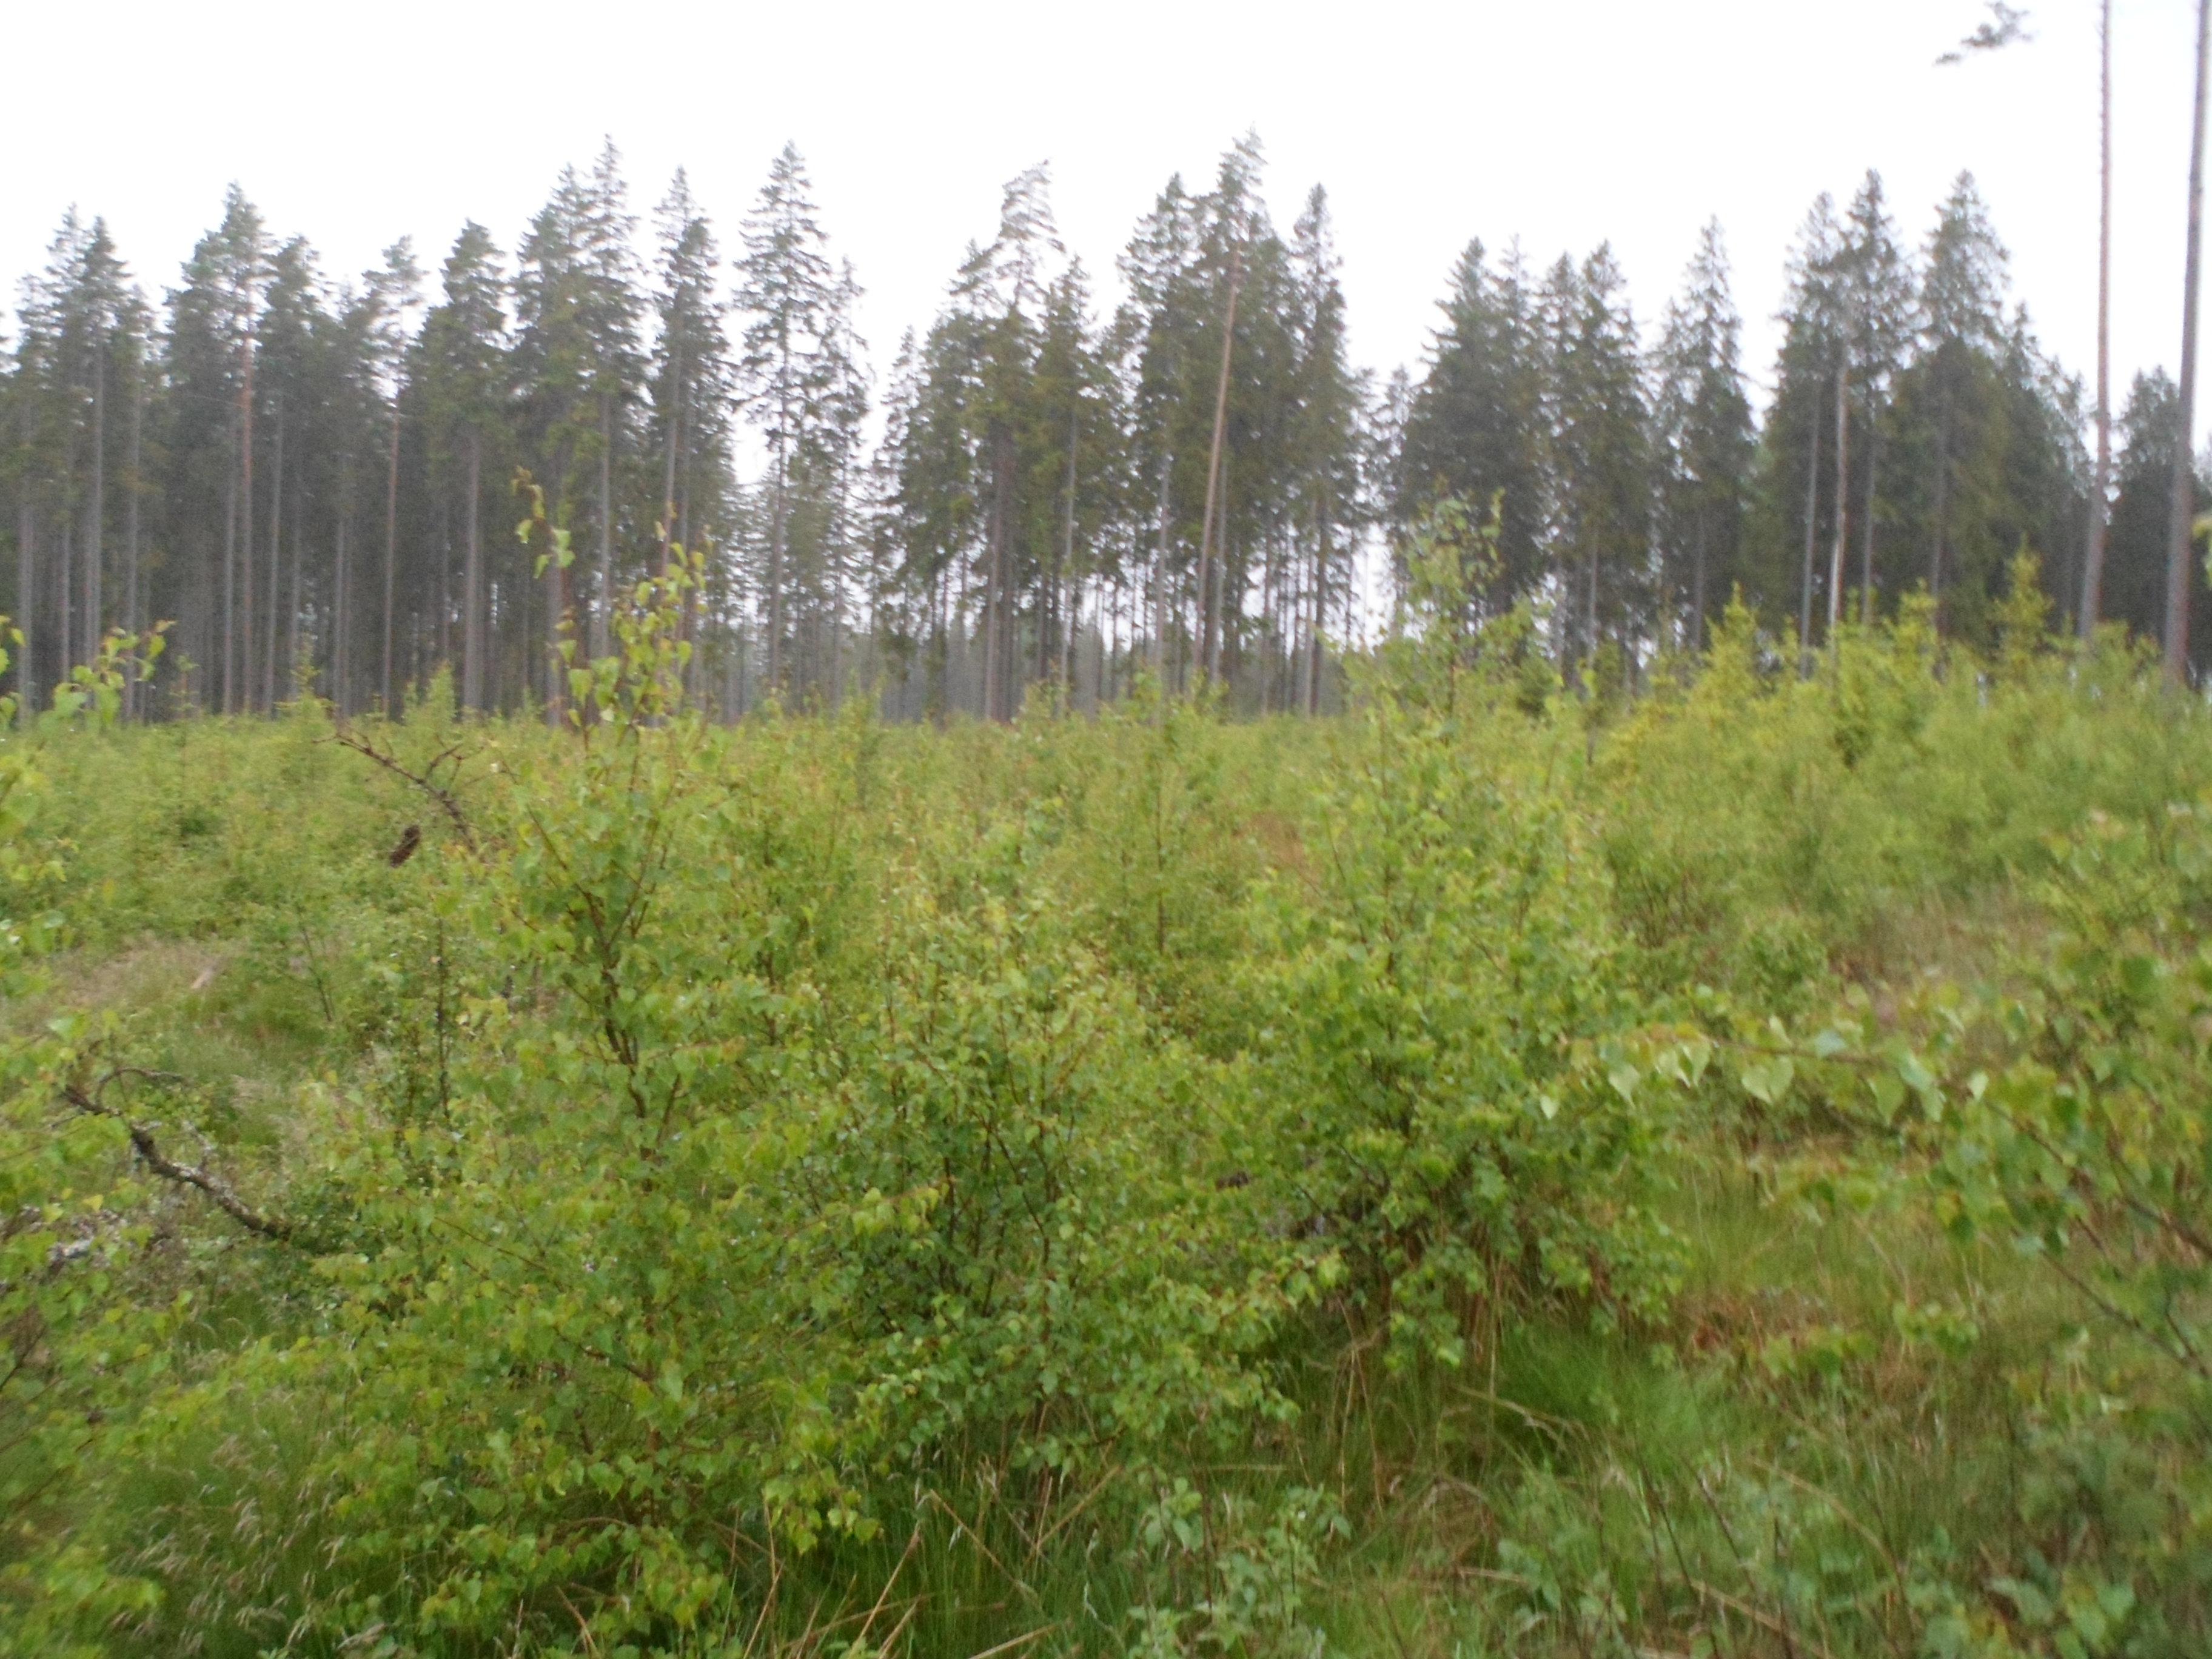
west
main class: Woodland
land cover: Broadleaved woodland
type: boreal forest
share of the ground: 50 - 75 %
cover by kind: broadleaved forest trees 65 %, herbaceous plants 20 %, shrubs 10 %, coniferous forest trees 5 %
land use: Forestry
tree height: > 5 m
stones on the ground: < 10 %
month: June
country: SE
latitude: 57.6316
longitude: 14.1989
